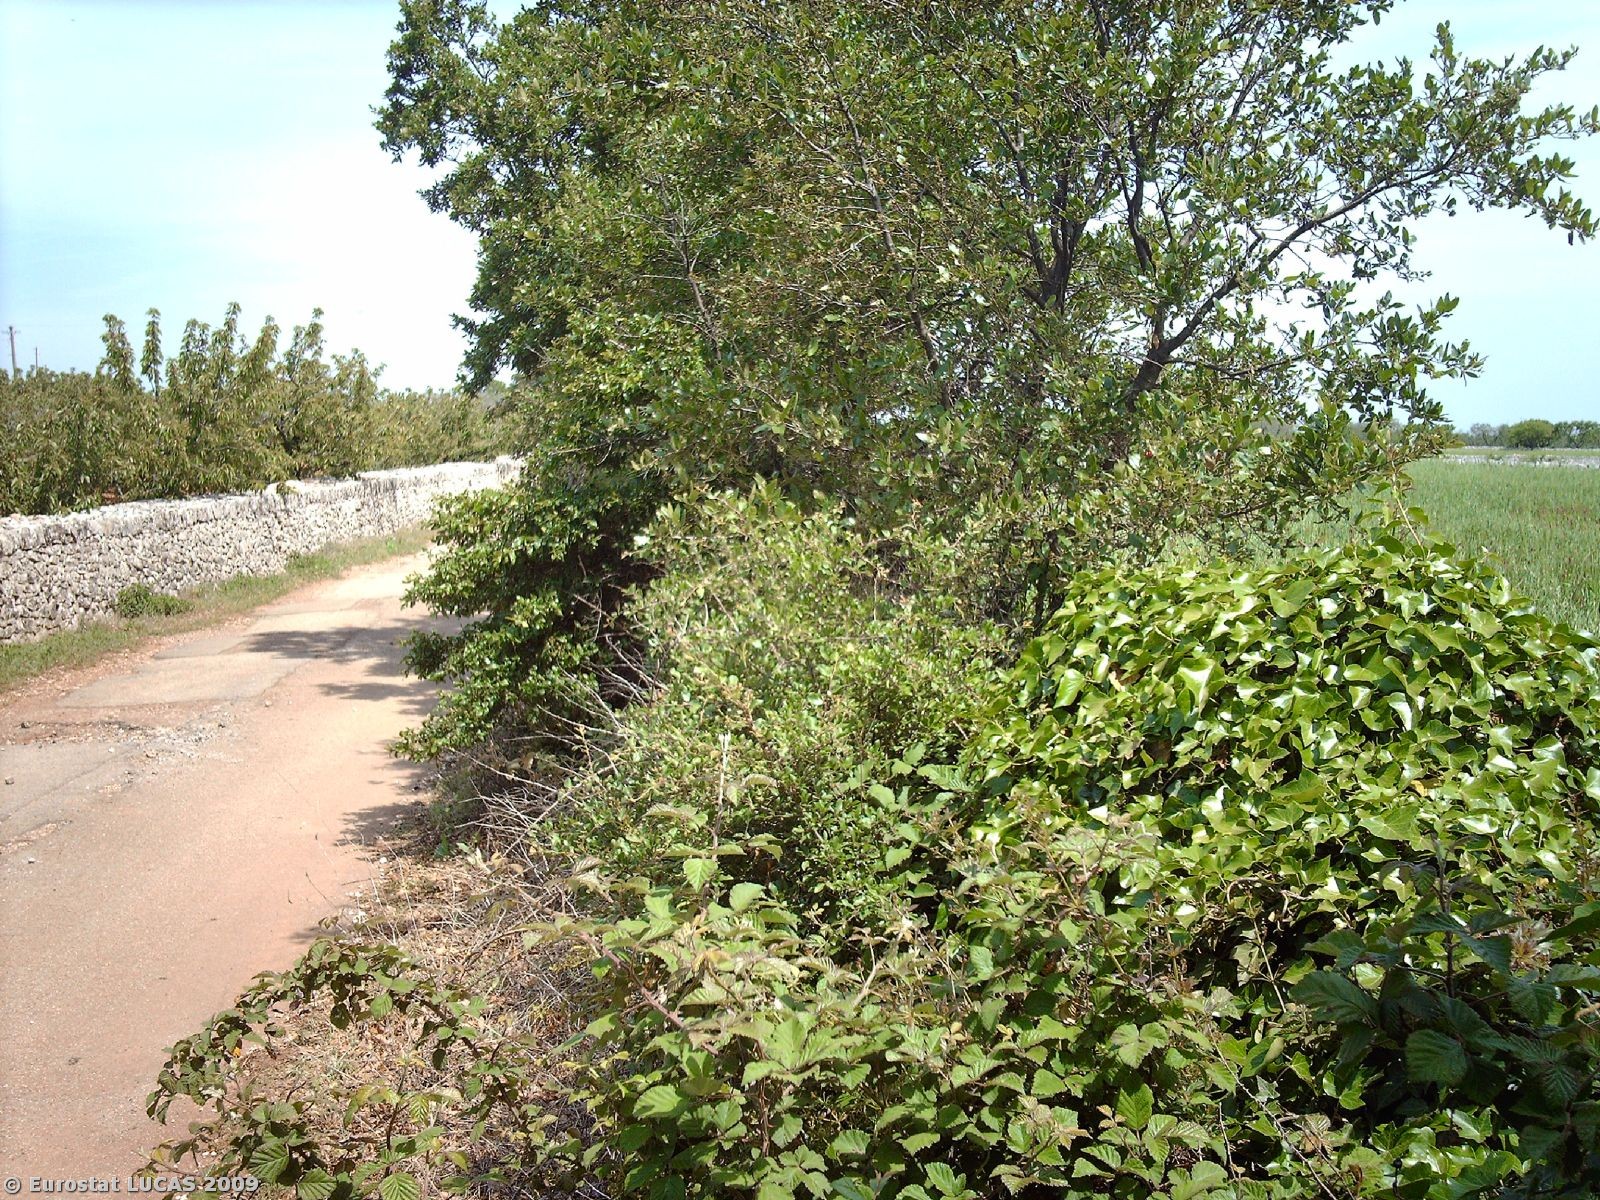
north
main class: Cropland
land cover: Mixed cereals for fodder
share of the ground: > 75 %
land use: Agriculture (excluding fallow land and kitchen gardens)
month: May
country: IT
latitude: 40.8659
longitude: 17.0611
